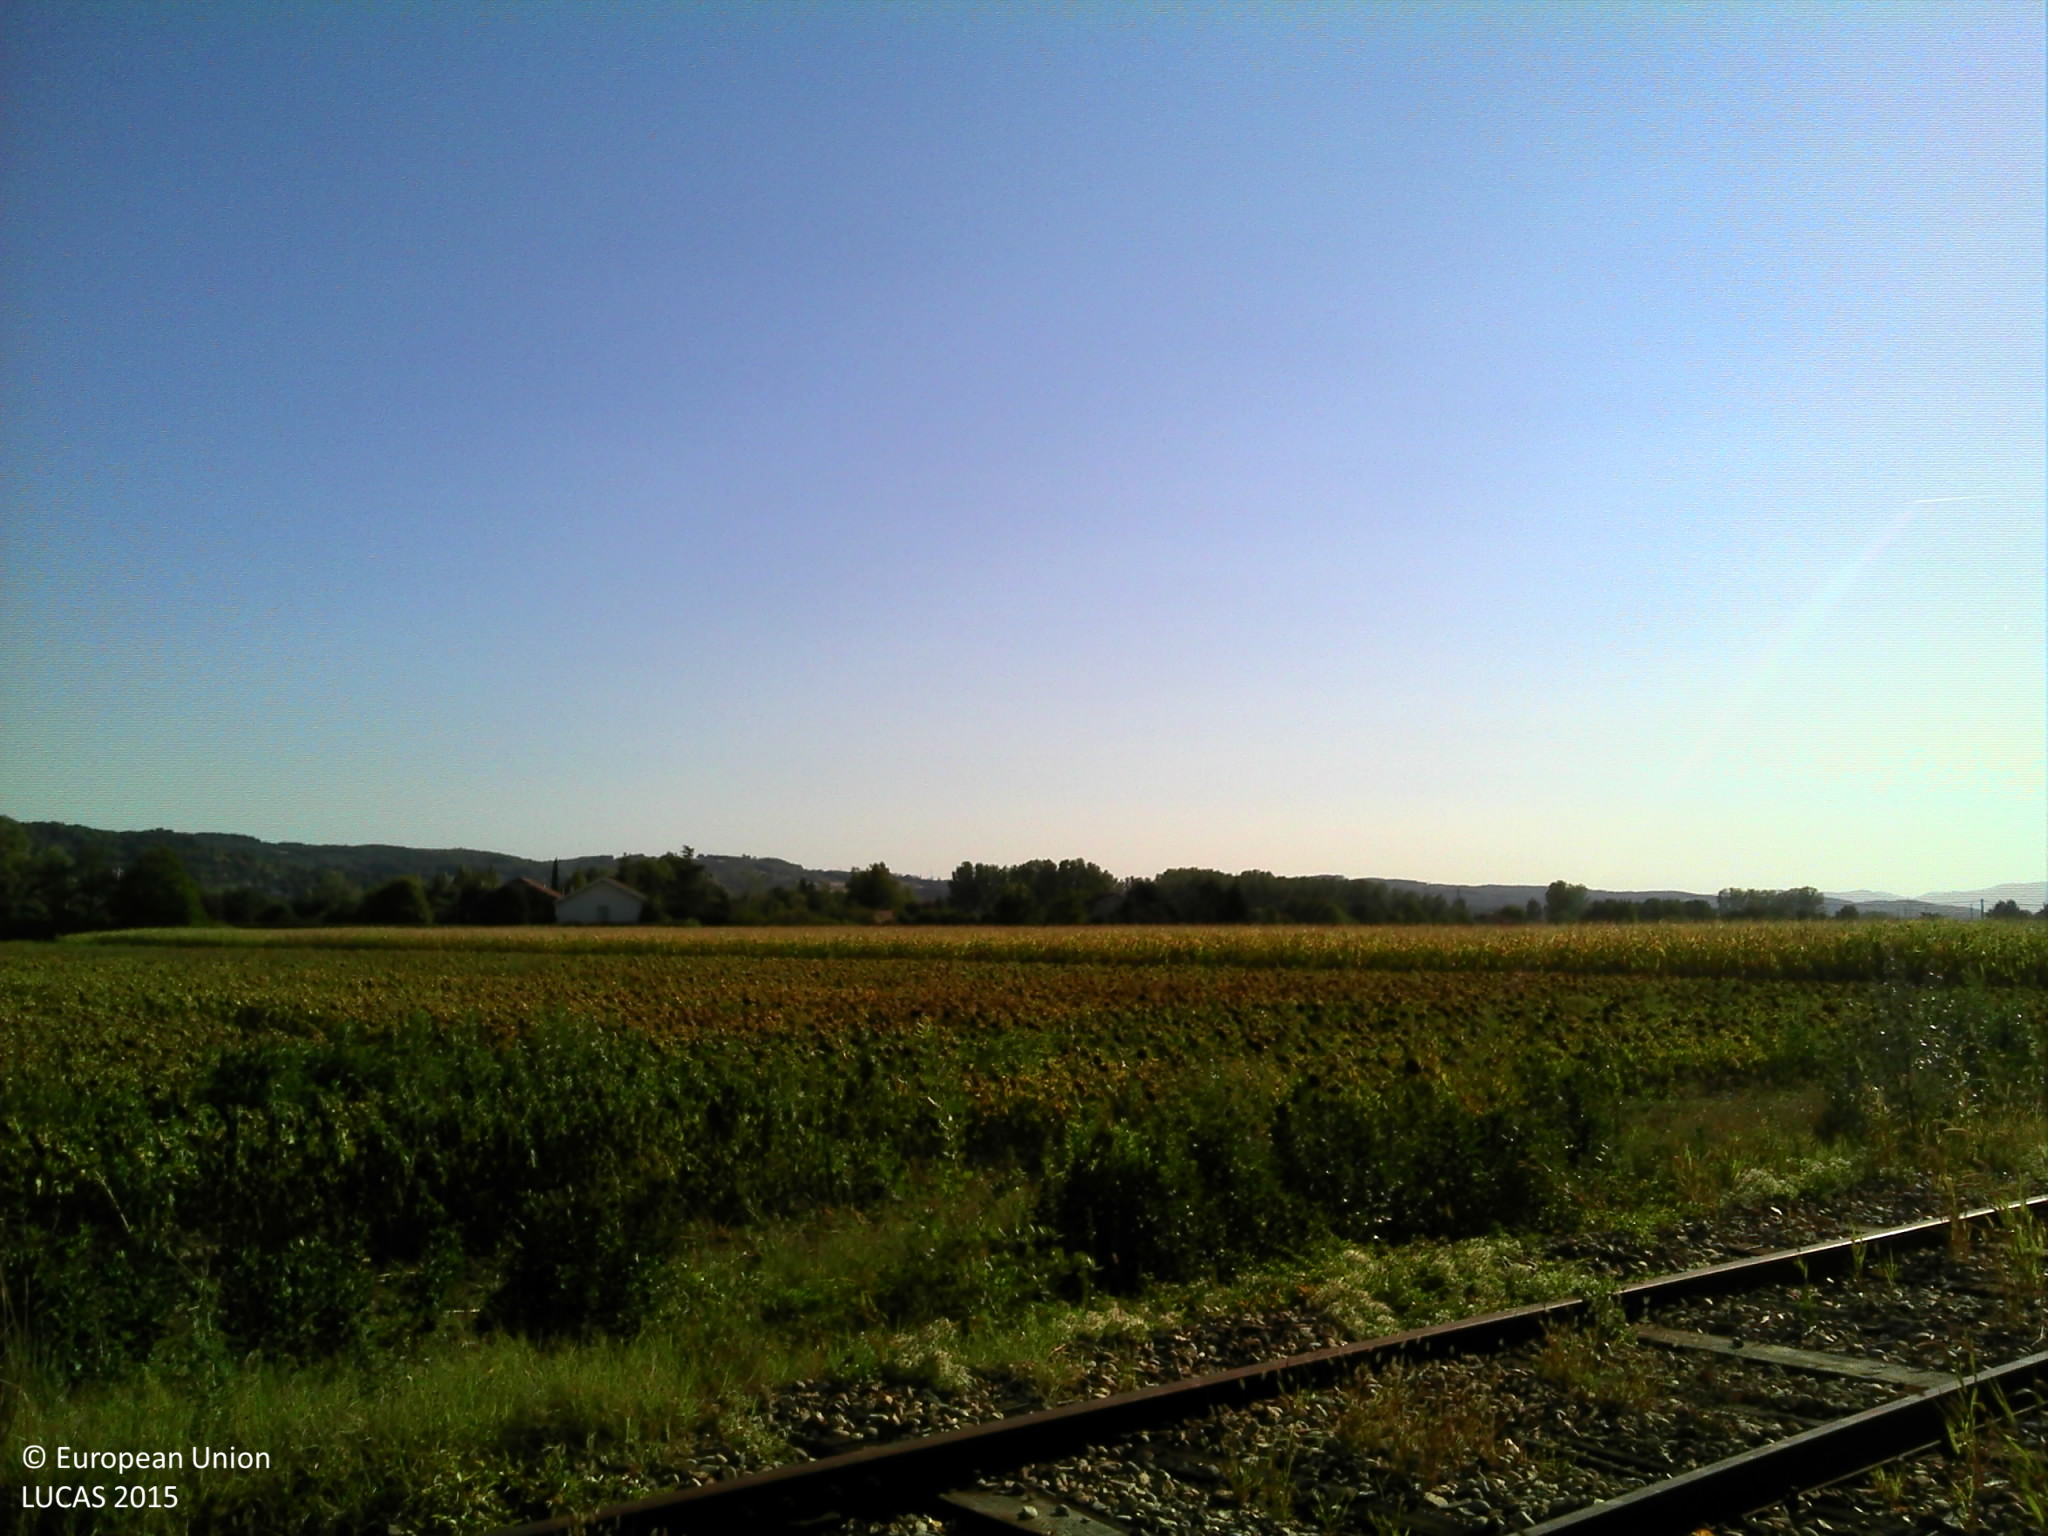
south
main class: Woodland
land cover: Broadleaved woodland
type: mesophytic deciduous forest
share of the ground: > 75 %
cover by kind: broadleaved forest trees 85 %, shrubs 10 %, coniferous forest trees 5 %
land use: Semi-natural and natural areas not in use
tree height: > 5 m
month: September
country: FR
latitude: 45.3134
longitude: 4.9919
